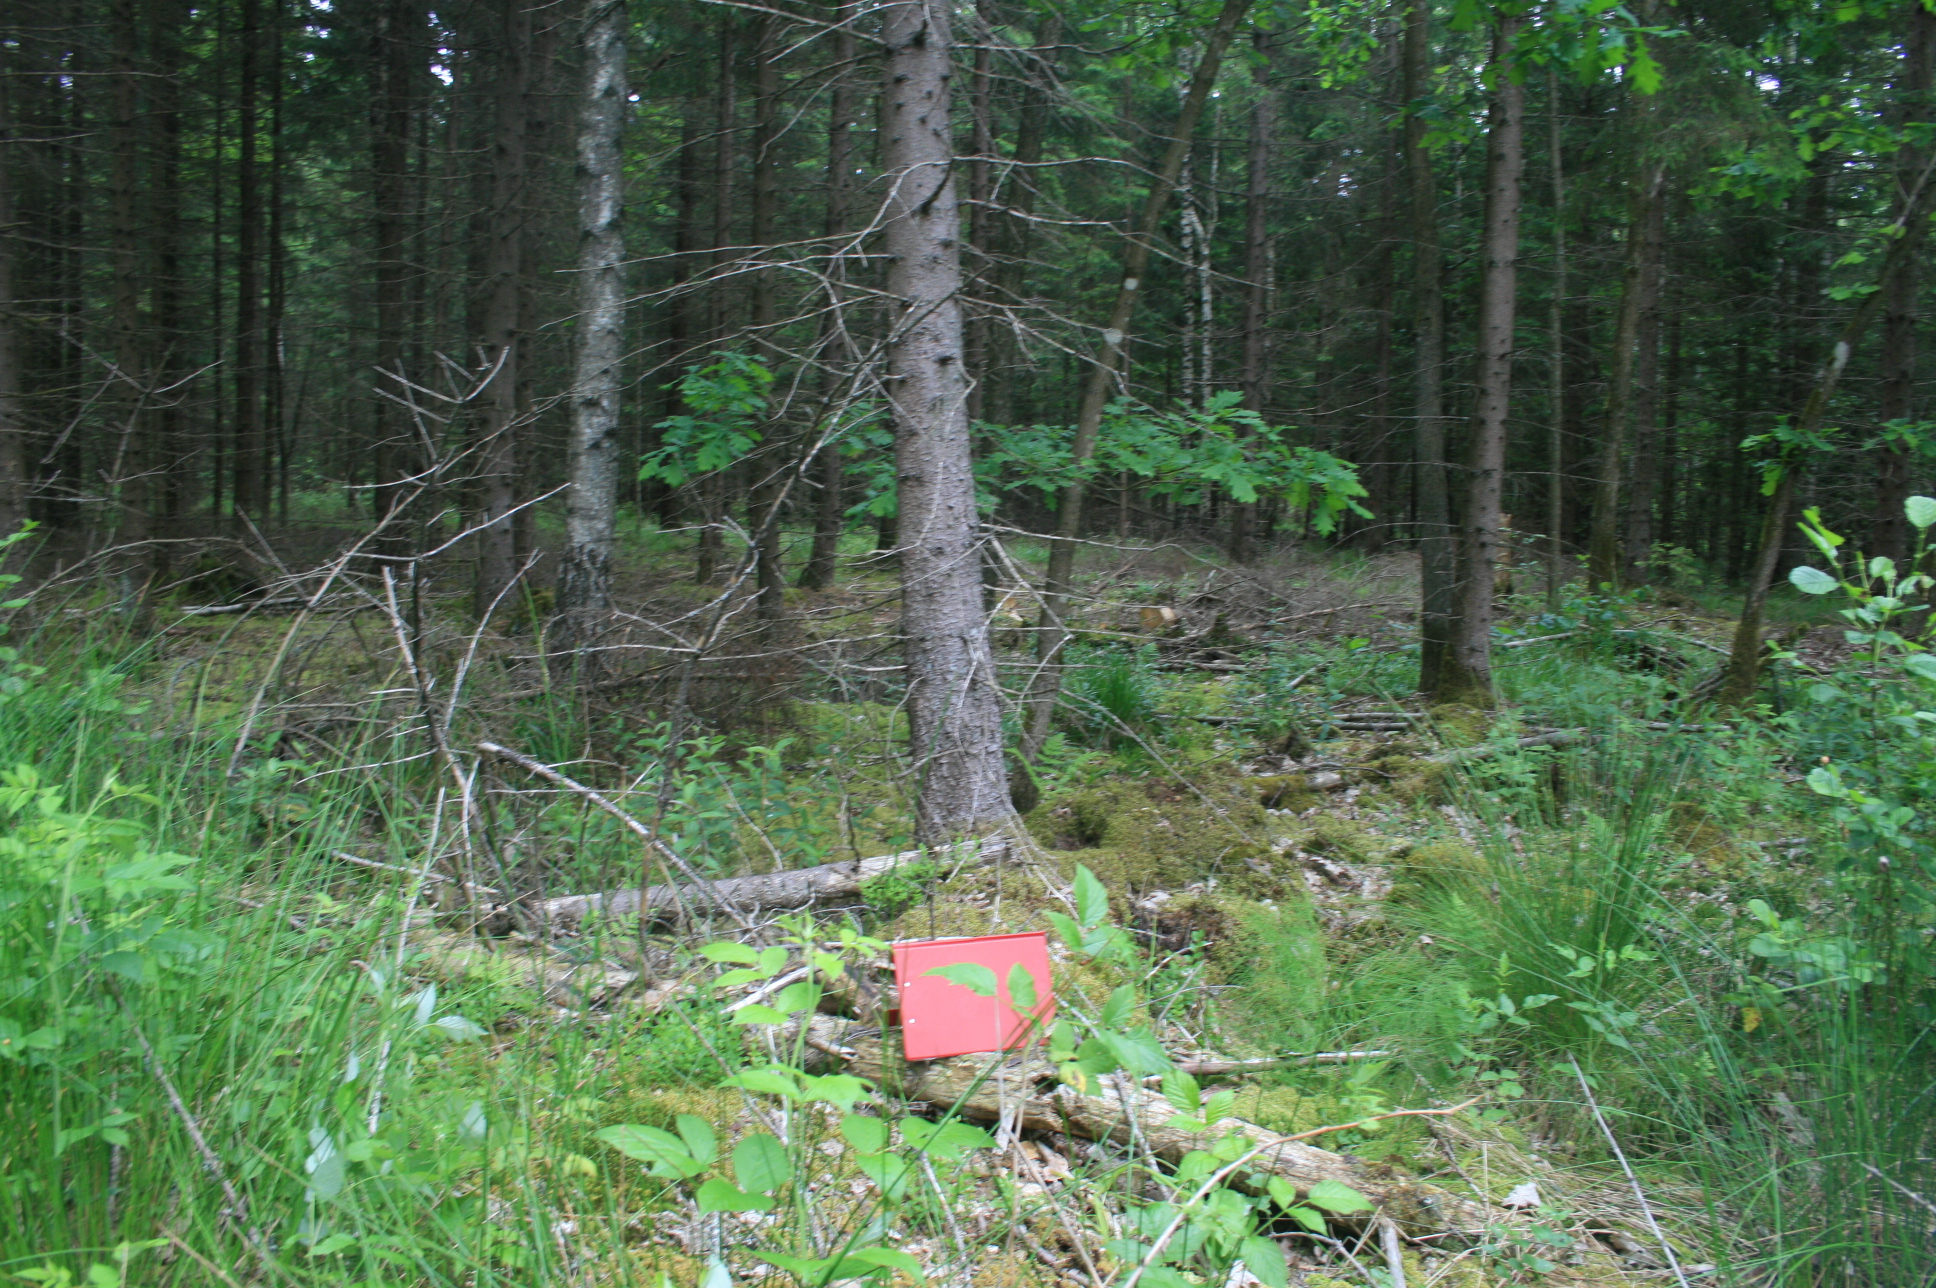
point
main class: Woodland
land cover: Spruce dominated mixed woodland
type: hemiboreal forest and nemoral coniferous forest and mixed broadleaved-coniferous forest
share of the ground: > 75 %
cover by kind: coniferous forest trees 65 %, broadleaved forest trees 30 %, herbaceous plants 5 %
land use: Forestry
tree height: > 5 m
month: June
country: LT
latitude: 55.3203
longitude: 22.1109
